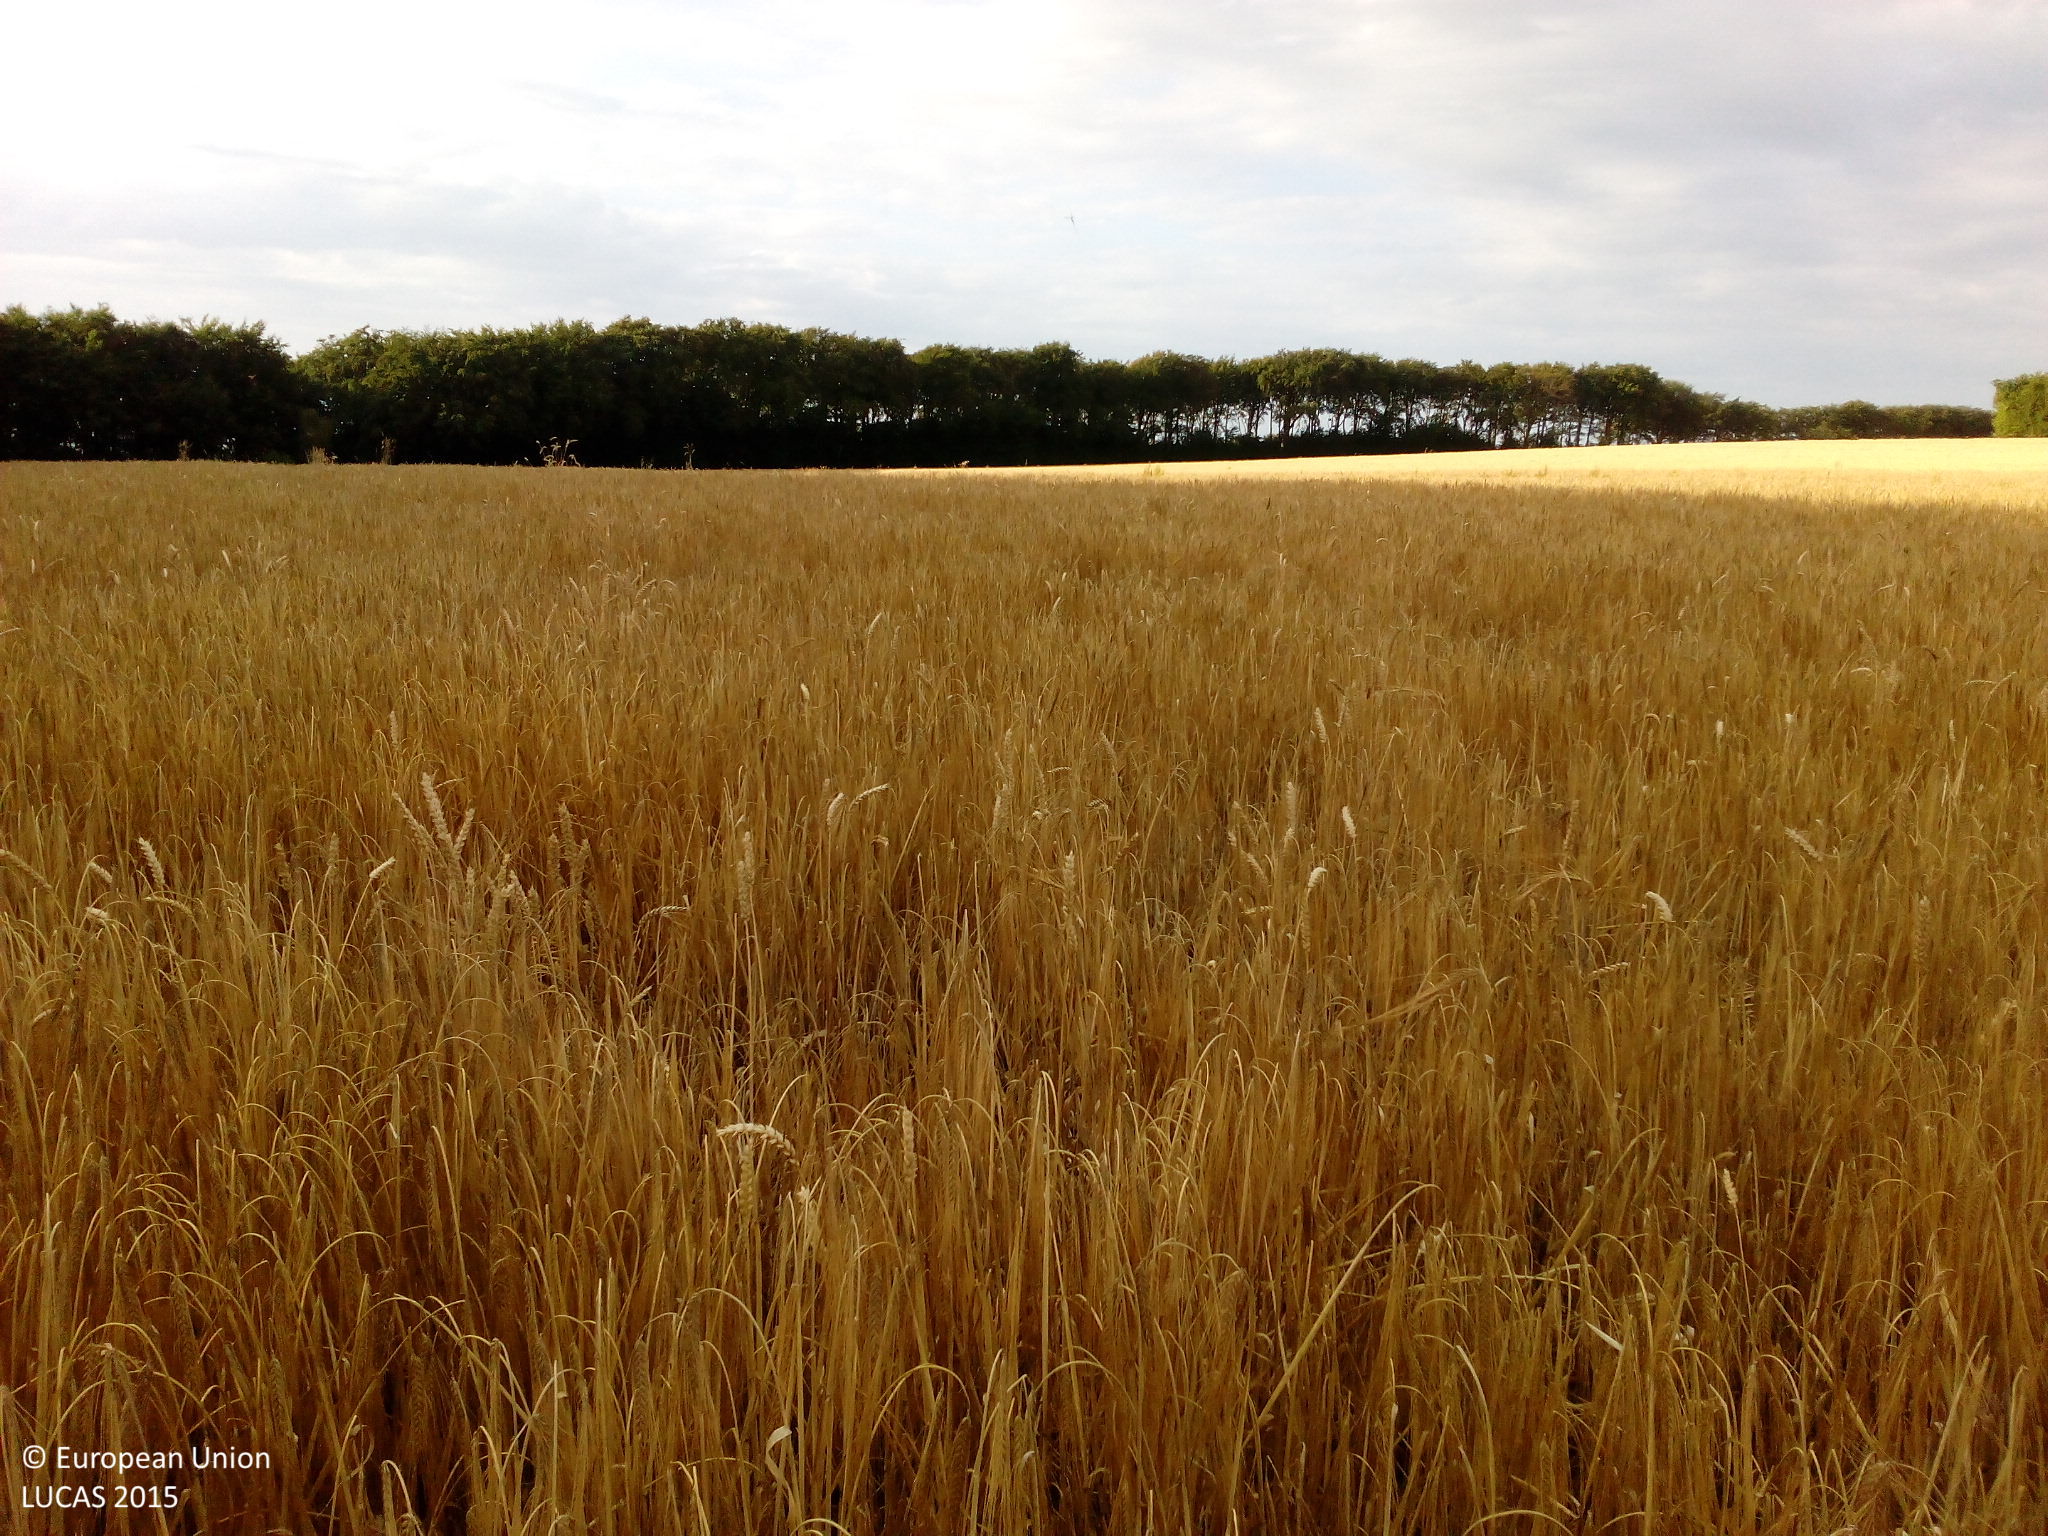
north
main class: Cropland
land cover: Barley
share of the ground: > 75 %
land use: Agriculture (excluding fallow land and kitchen gardens)
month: July
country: DK
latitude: 55.8141
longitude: 11.8972
